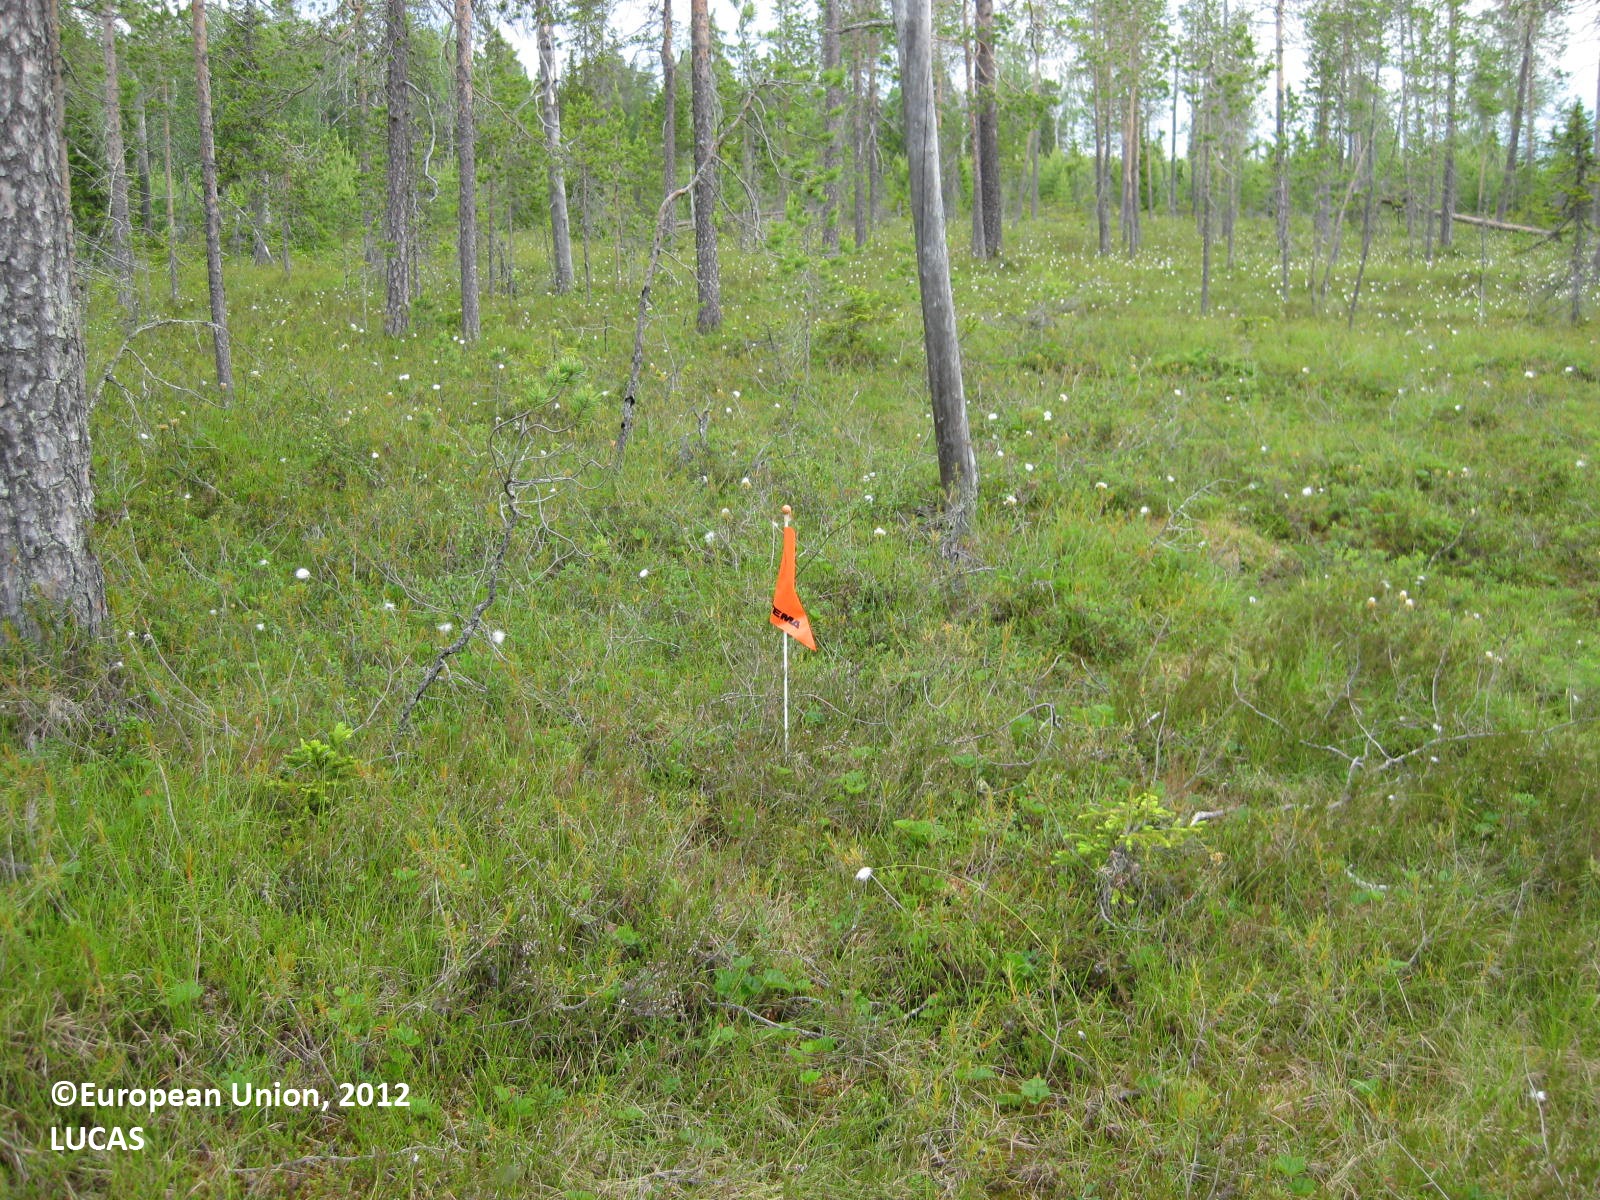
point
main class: Woodland
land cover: Pine dominated coniferous woodland
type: mire and swamp forests
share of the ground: 25 - 50 %
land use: Semi-natural and natural areas not in use
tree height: > 5 m
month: July
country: FI
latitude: 65.5471
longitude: 29.2173
